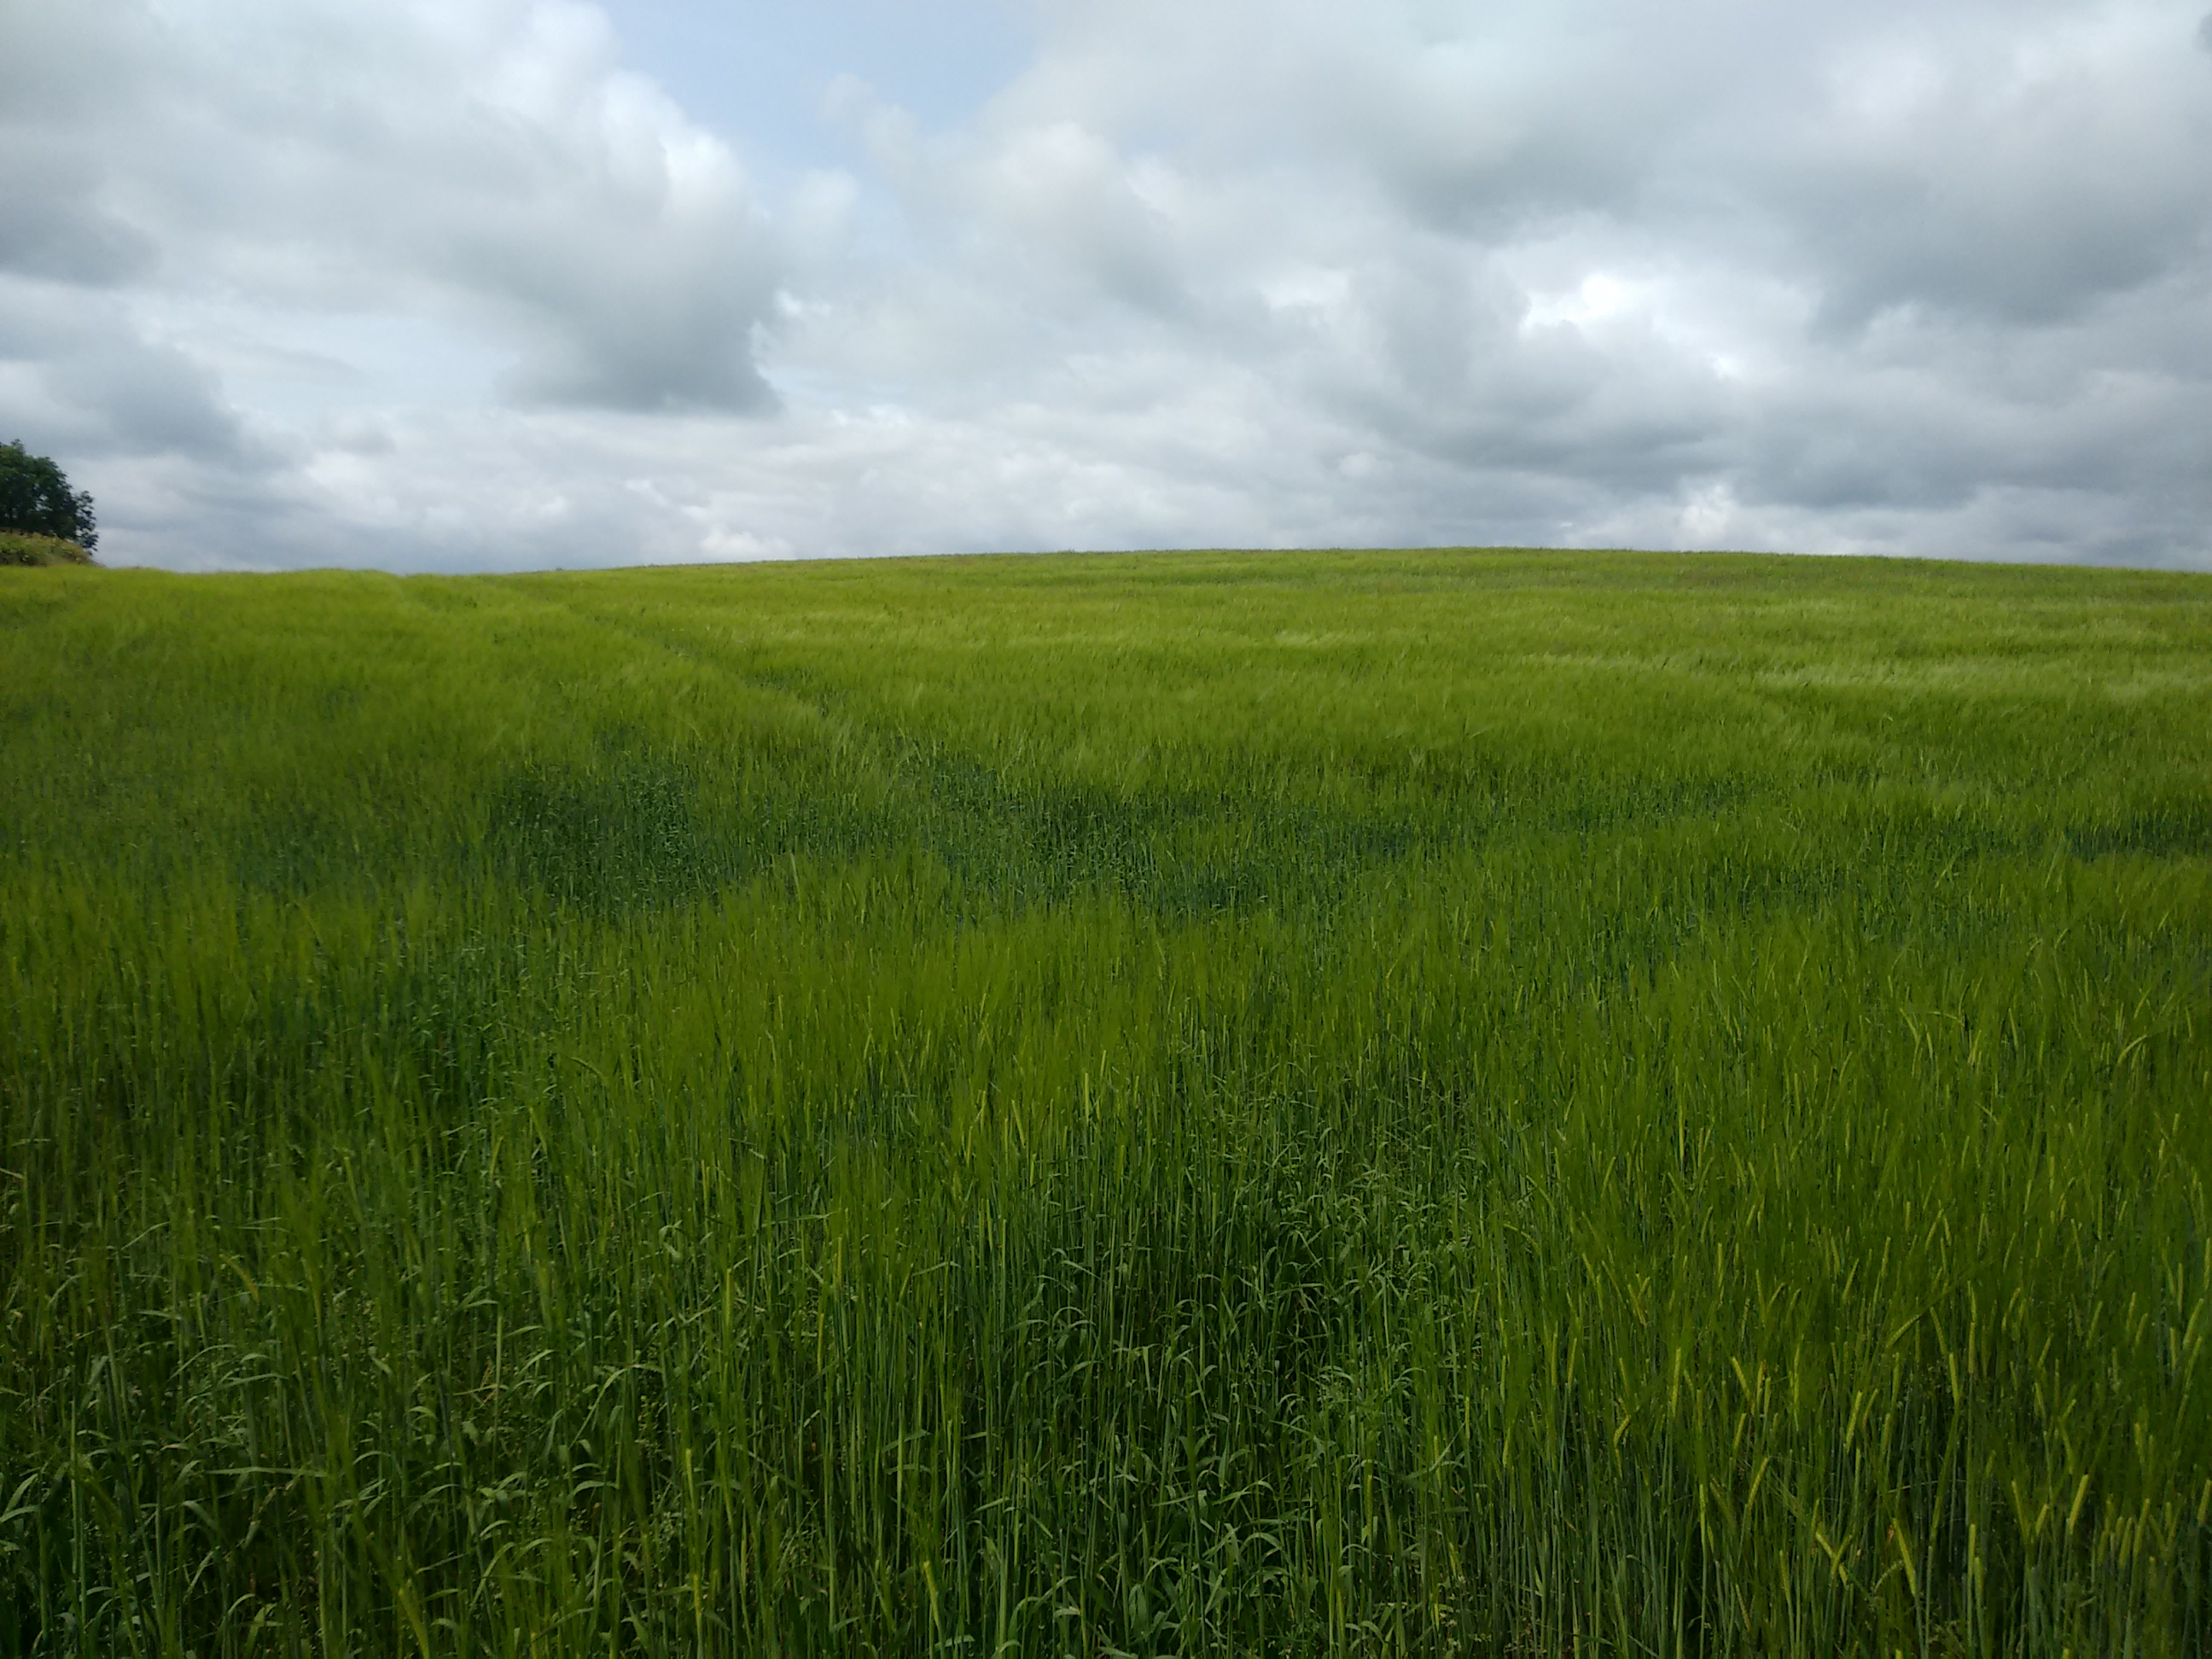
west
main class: Cropland
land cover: Barley
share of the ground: > 75 %
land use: Agriculture (excluding fallow land and kitchen gardens)
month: July
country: GB
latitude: 54.5523
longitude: -7.3272
